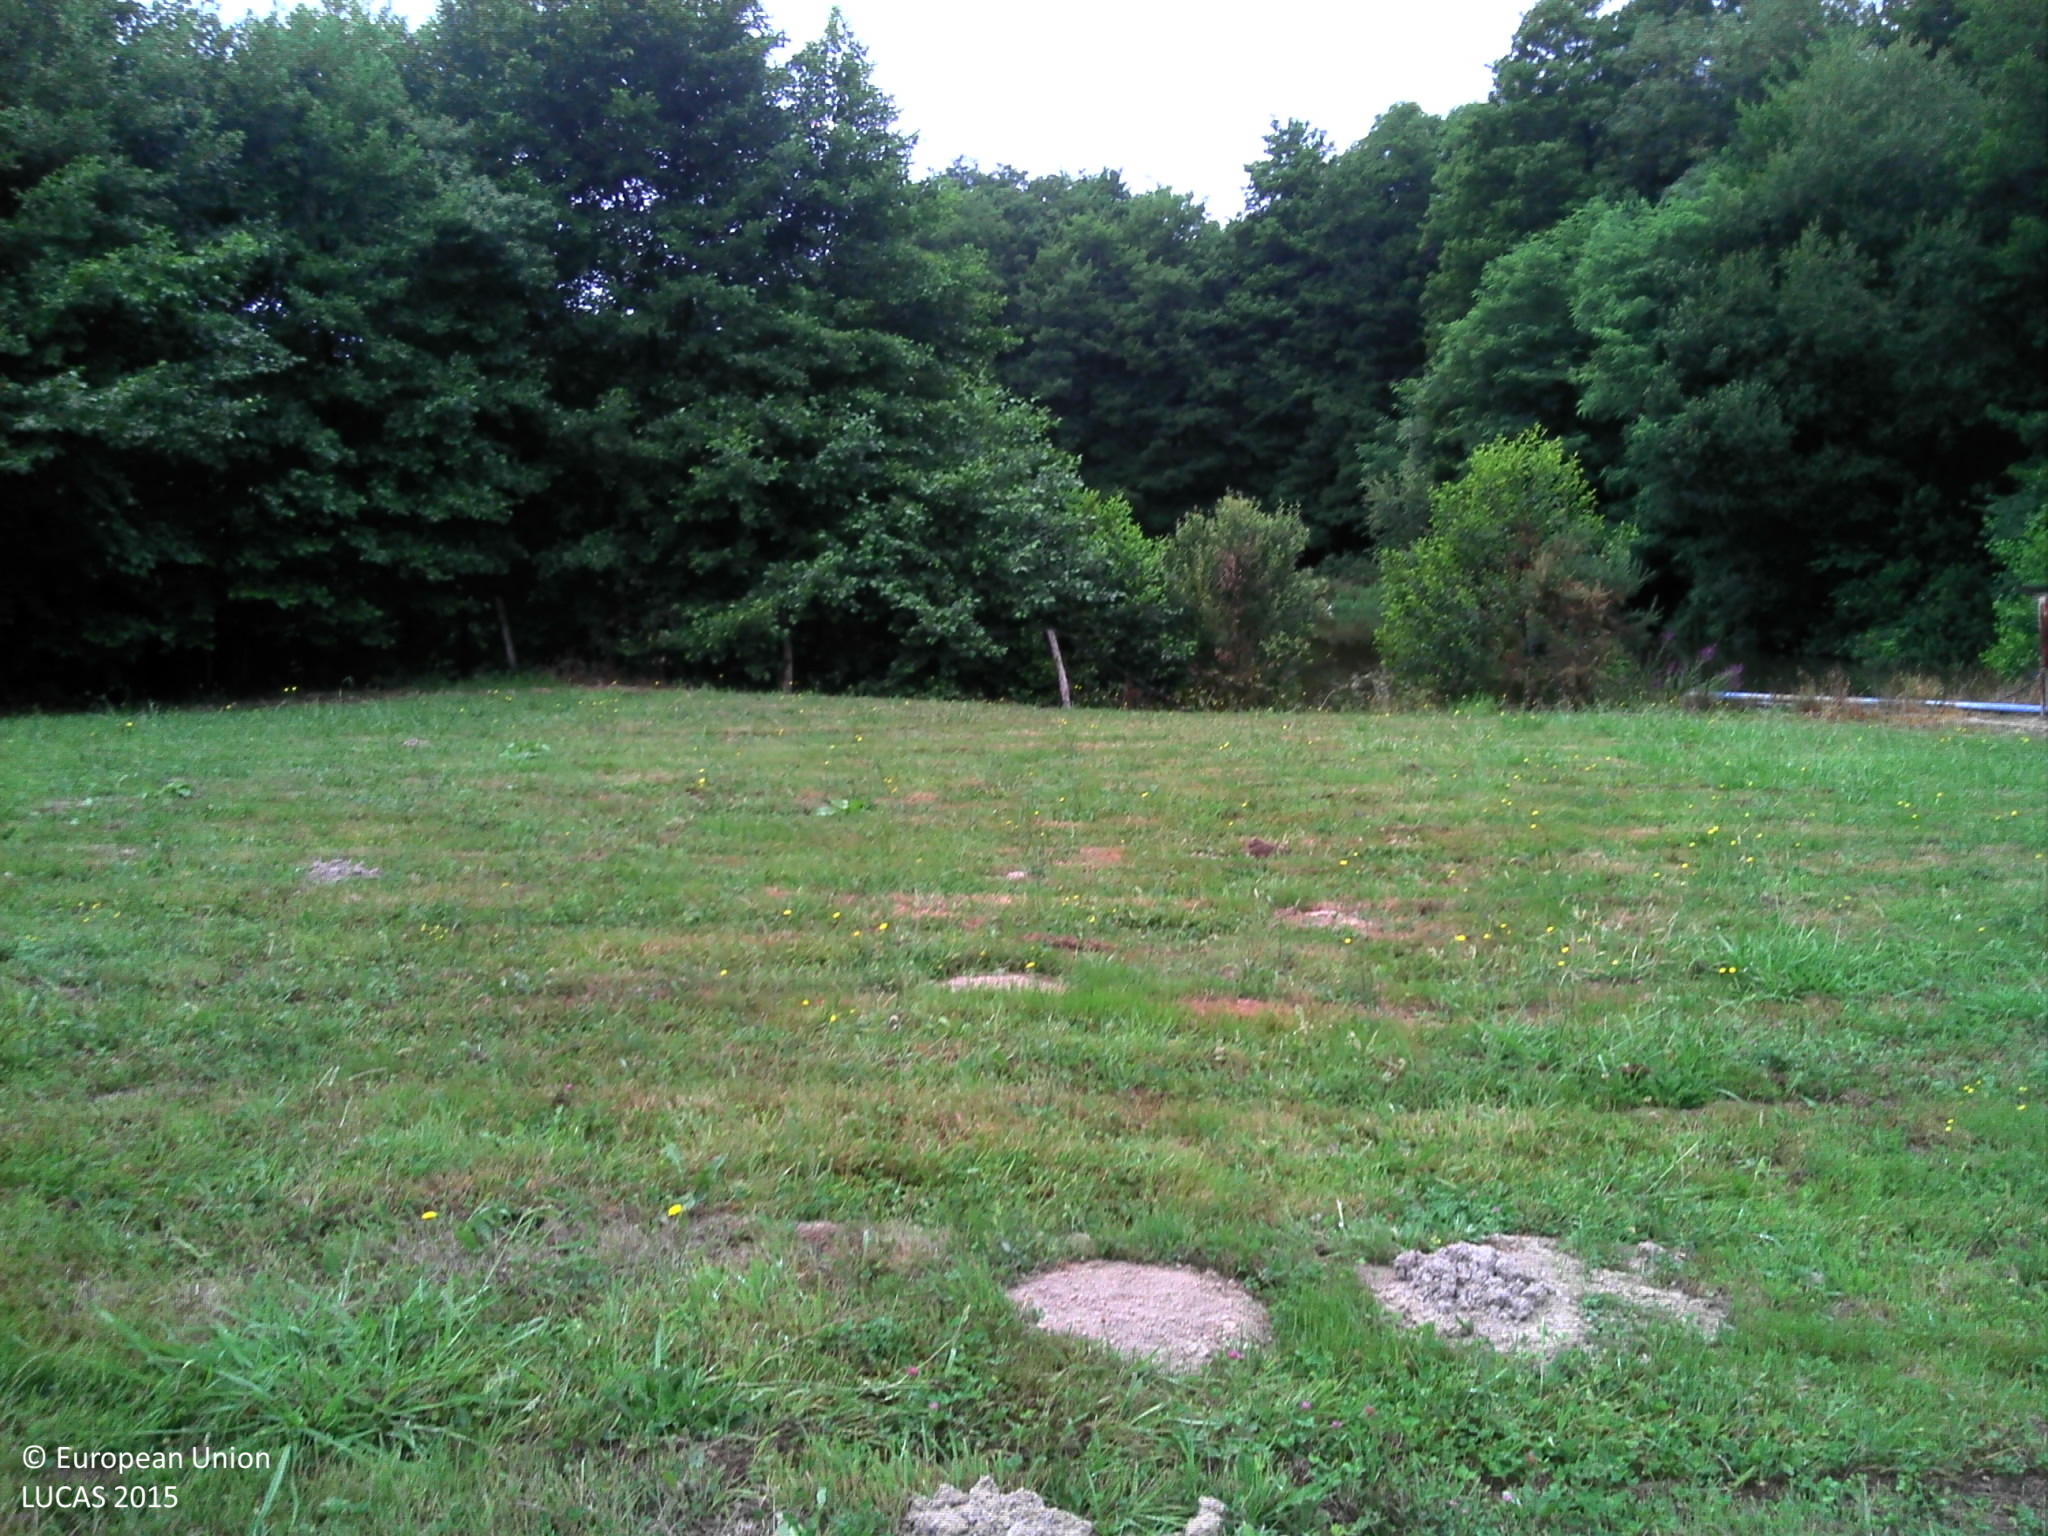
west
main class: Grassland
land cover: Grassland without tree/shrub cover
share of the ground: > 75 %
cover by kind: herbaceous plants 95 %, lichens and mosses 5 %
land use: Residential
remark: Clear cut
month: July
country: FR
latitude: 43.5554
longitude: -1.2440
